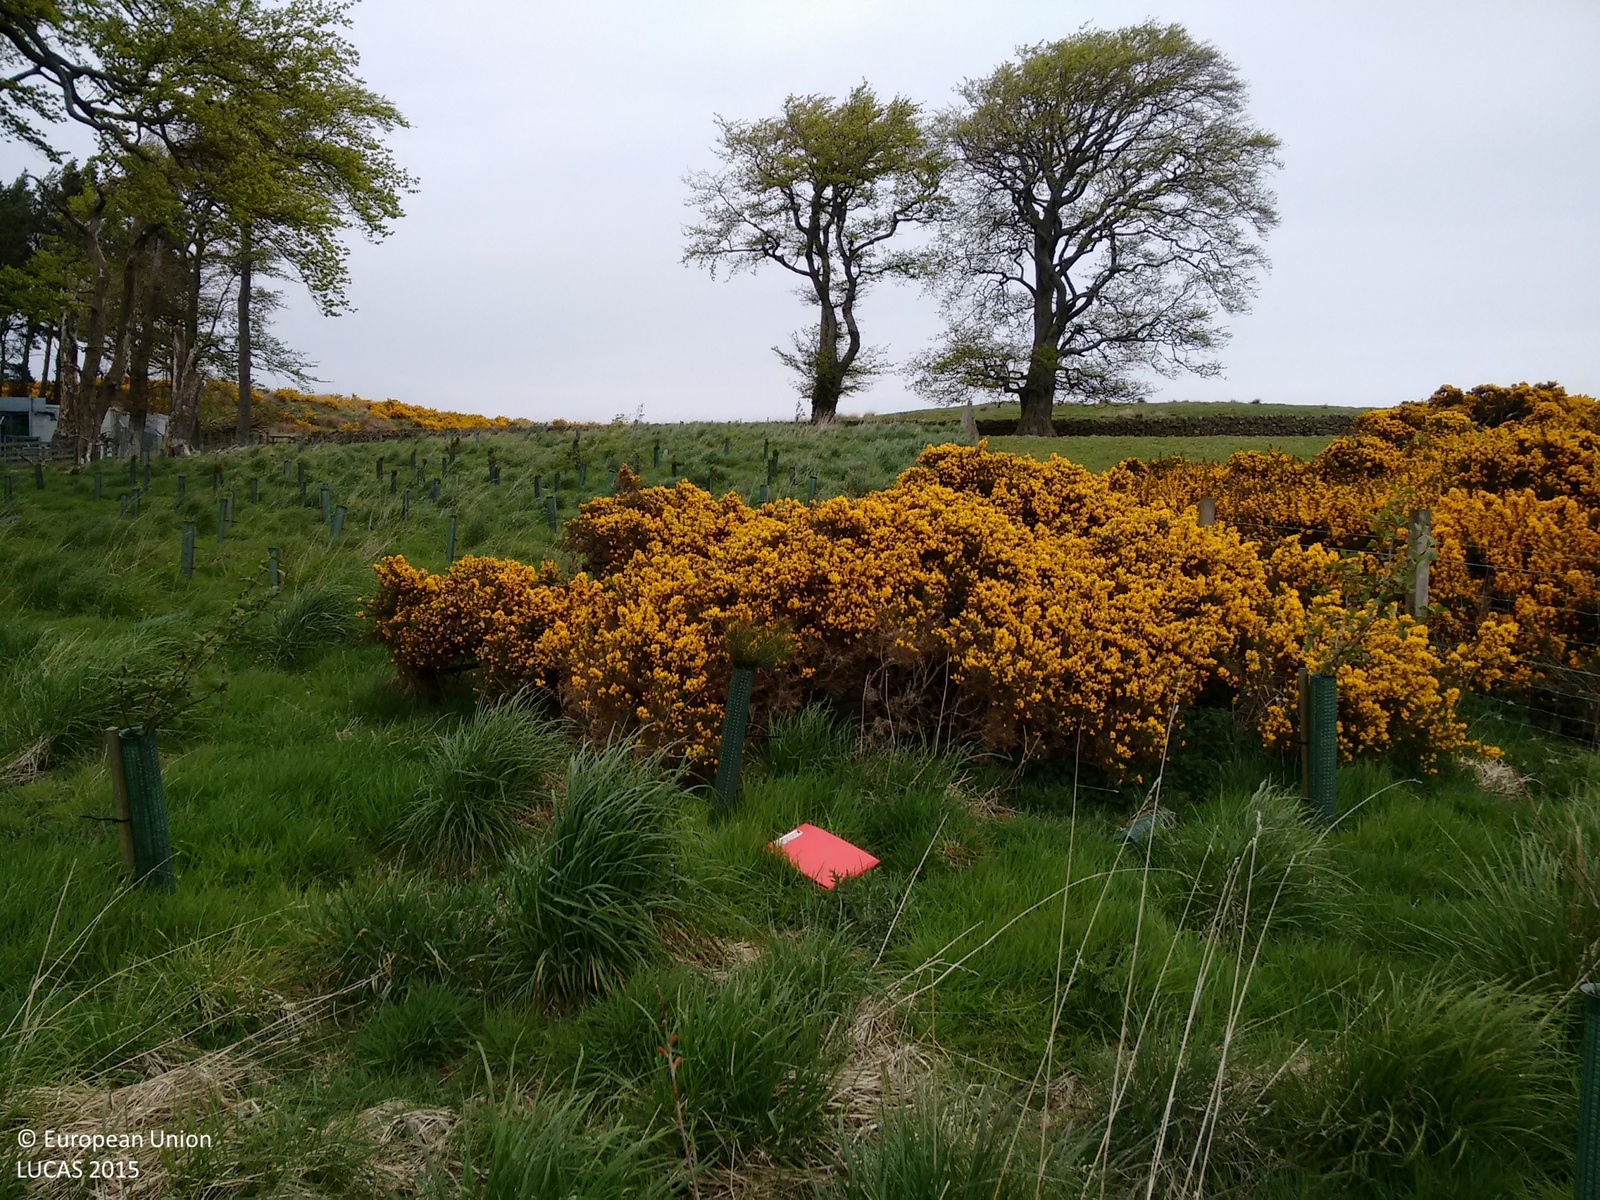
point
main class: Grassland
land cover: Grassland with sparse tree/shrub cover
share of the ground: > 75 %
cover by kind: herbaceous plants 90 %, broadleaved forest trees 5 %, shrubs 5 %
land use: Forestry
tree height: < 5 m
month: May
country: GB
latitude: 55.8864
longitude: -3.3608
